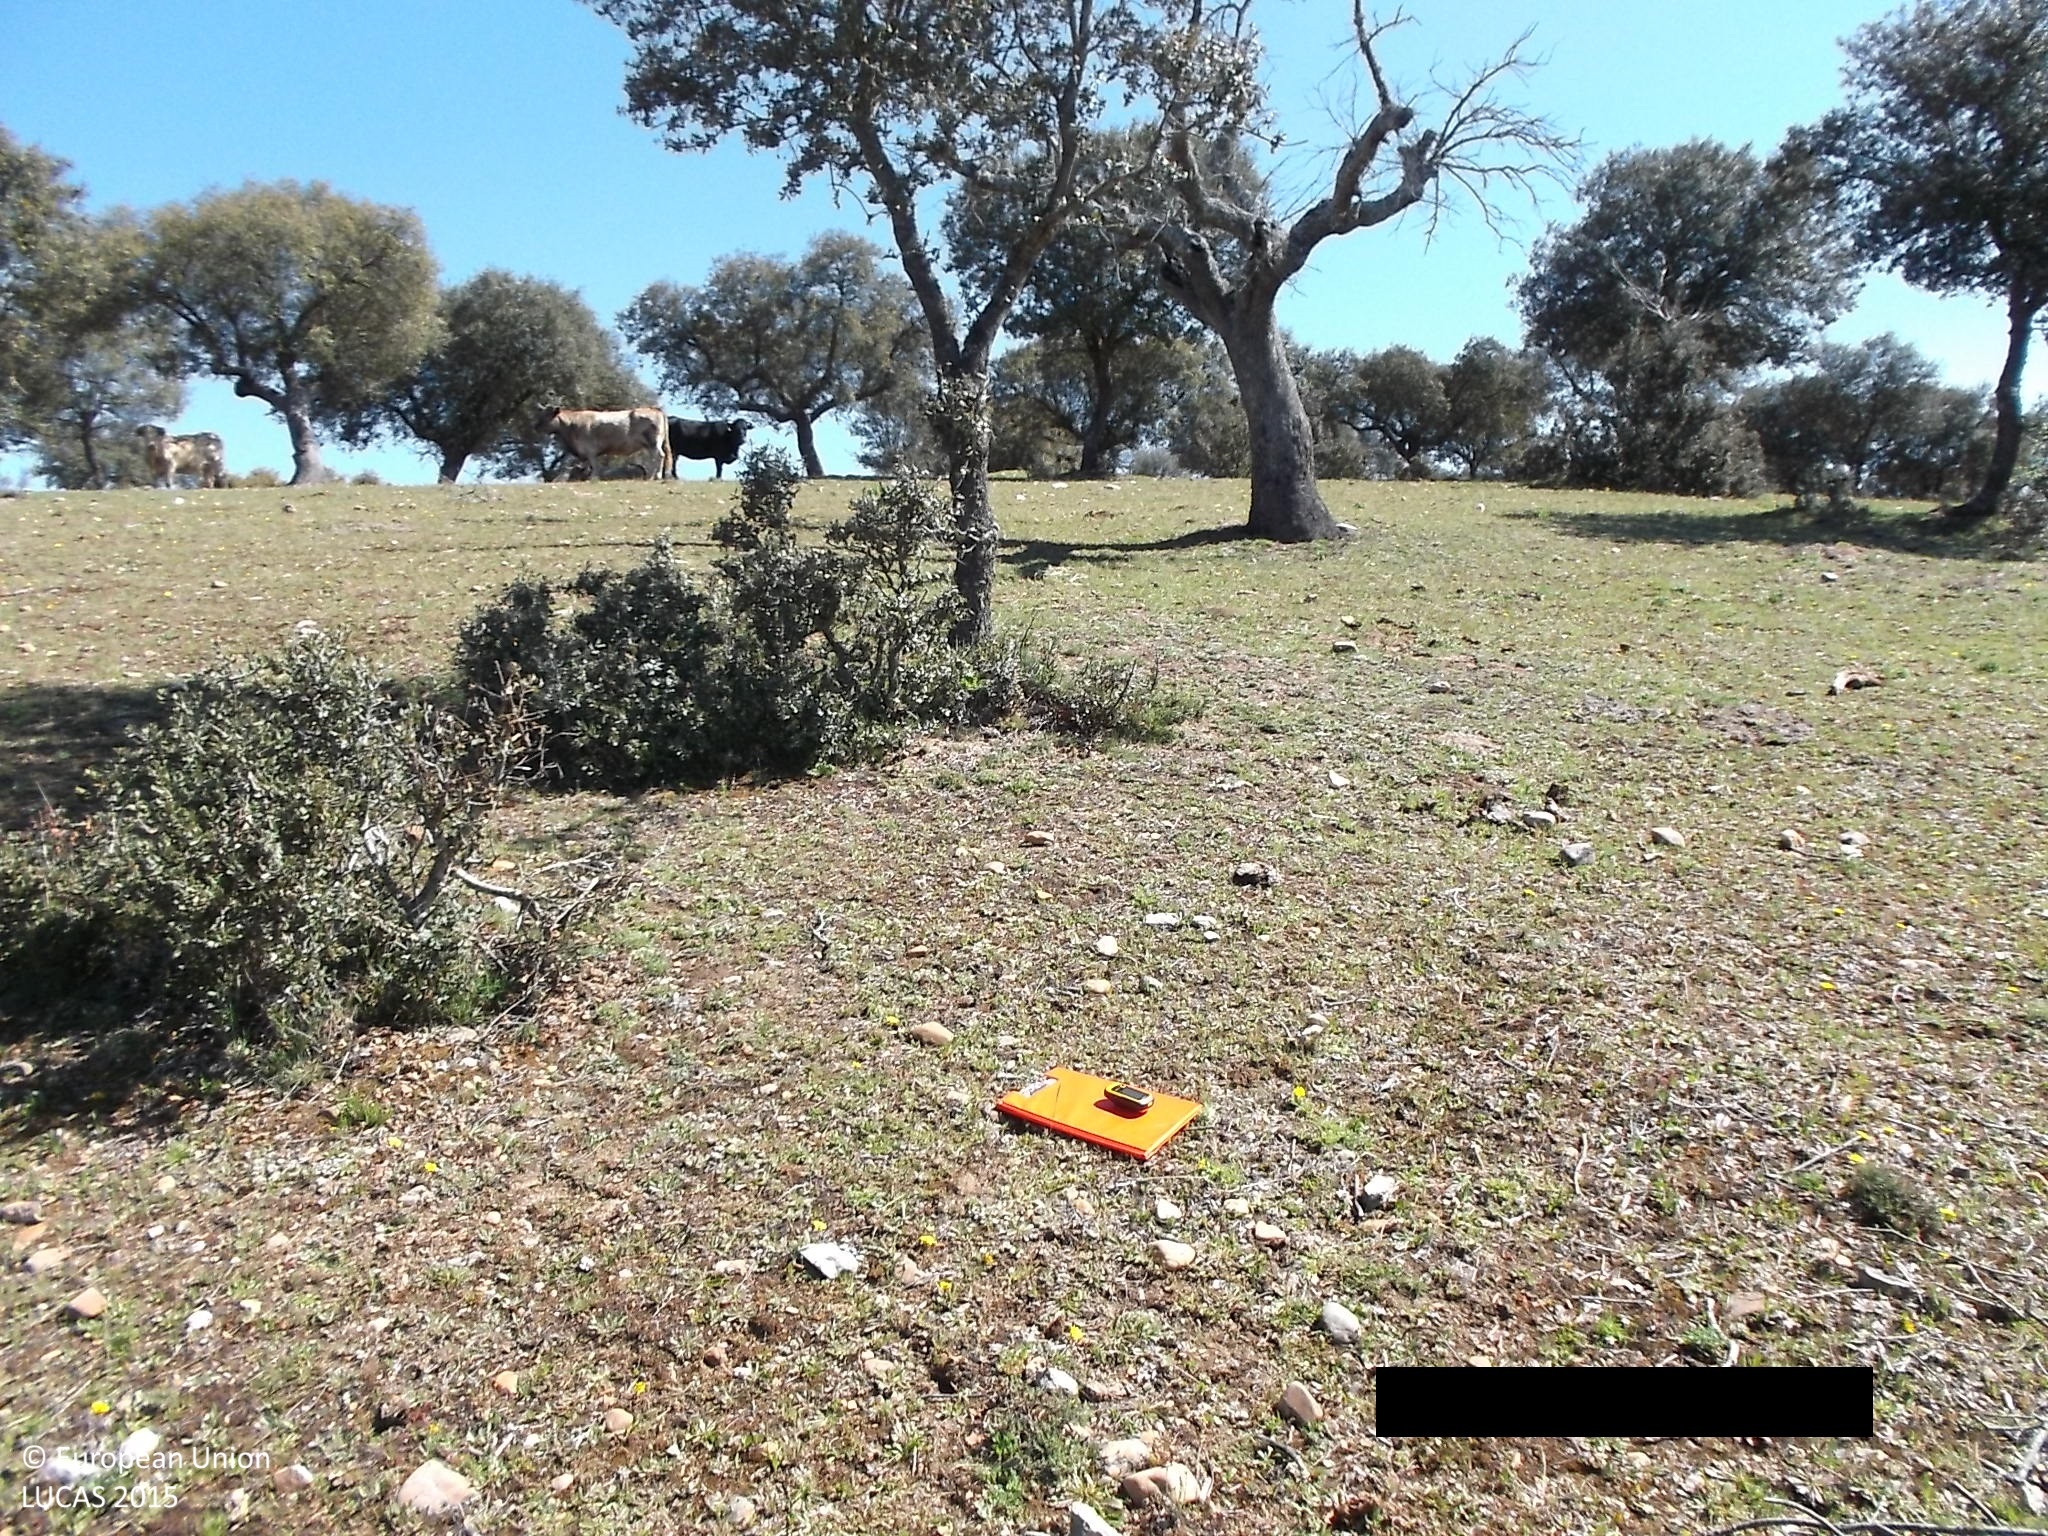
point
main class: Woodland
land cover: Broadleaved woodland
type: broadleaved evergreen forest
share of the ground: 25 - 50 %
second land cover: Grassland without tree/shrub cover
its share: 50 - 75 %
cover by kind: herbaceous plants 50 %, broadleaved forest trees 30 %, shrubs 20 %
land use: Forestry
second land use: Agriculture (excluding fallow land and kitchen gardens)
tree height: < 5 m
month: April
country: ES
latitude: 41.0722
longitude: -5.9249
